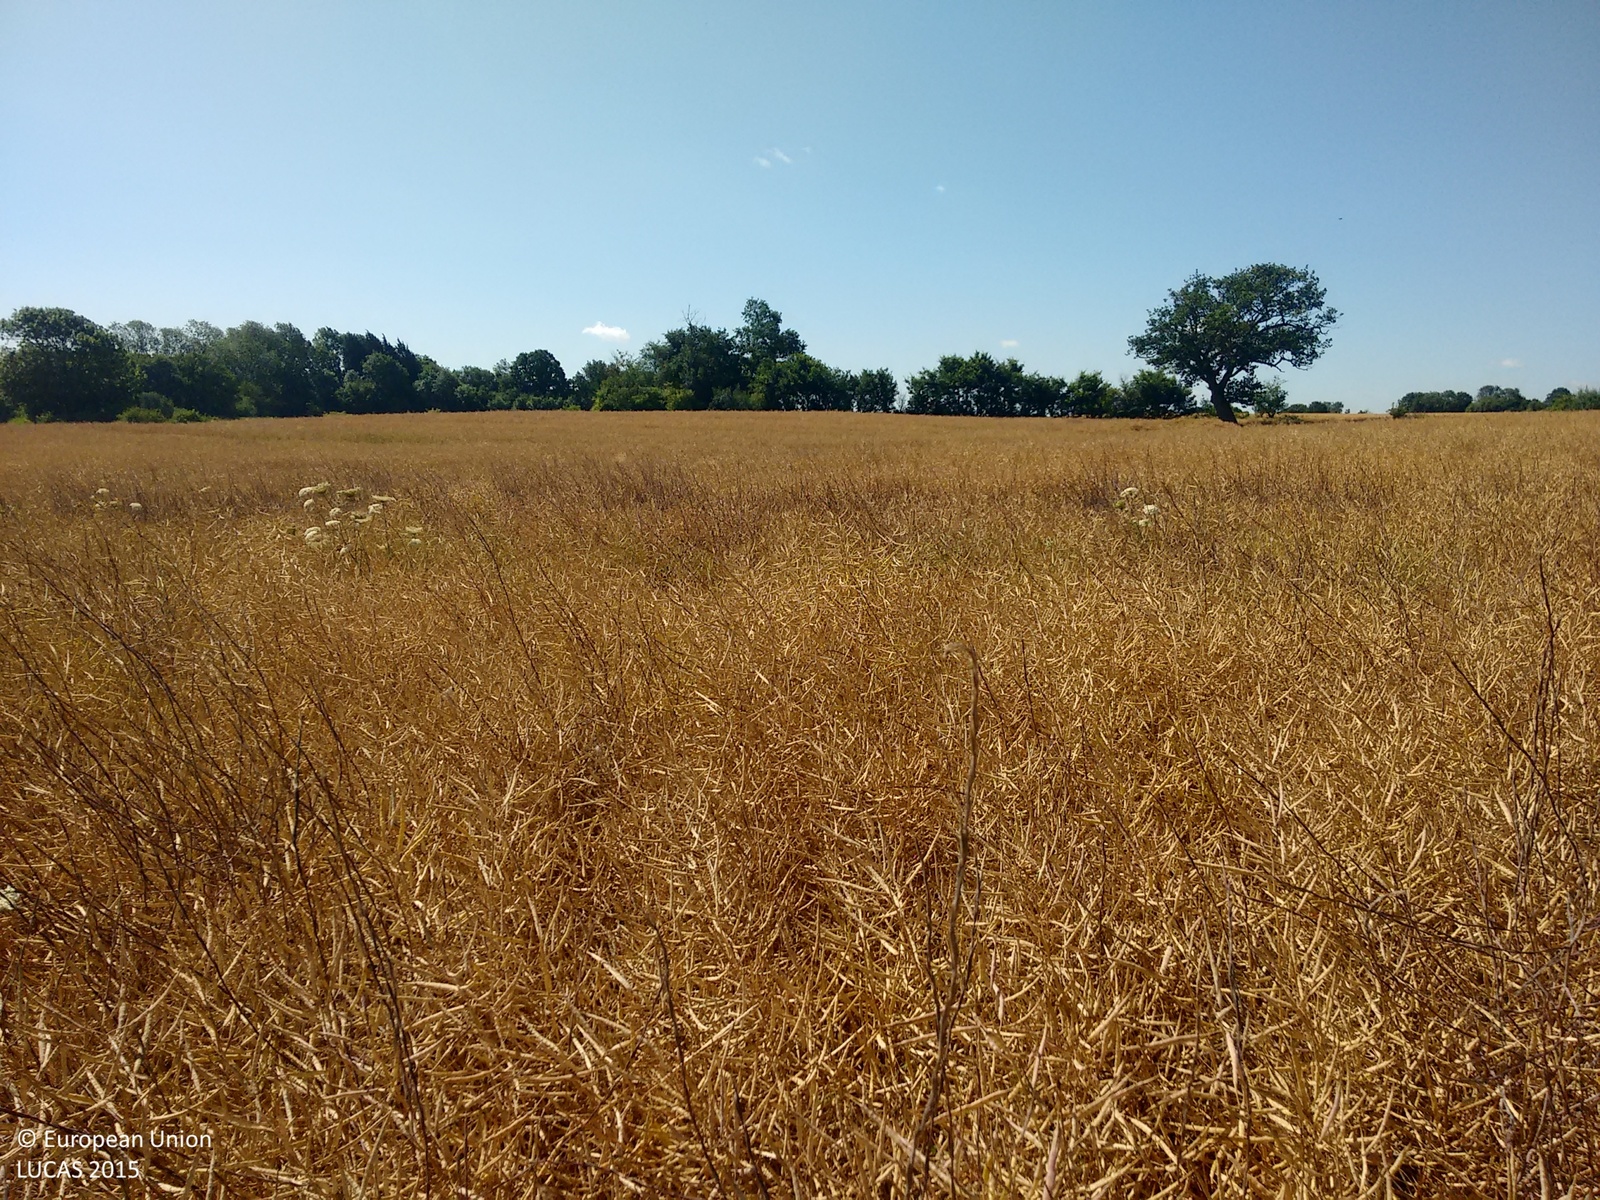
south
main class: Cropland
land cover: Rape and turnip rape
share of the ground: > 75 %
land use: Agriculture (excluding fallow land and kitchen gardens)
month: July
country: GB
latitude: 51.8586
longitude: 0.3732
